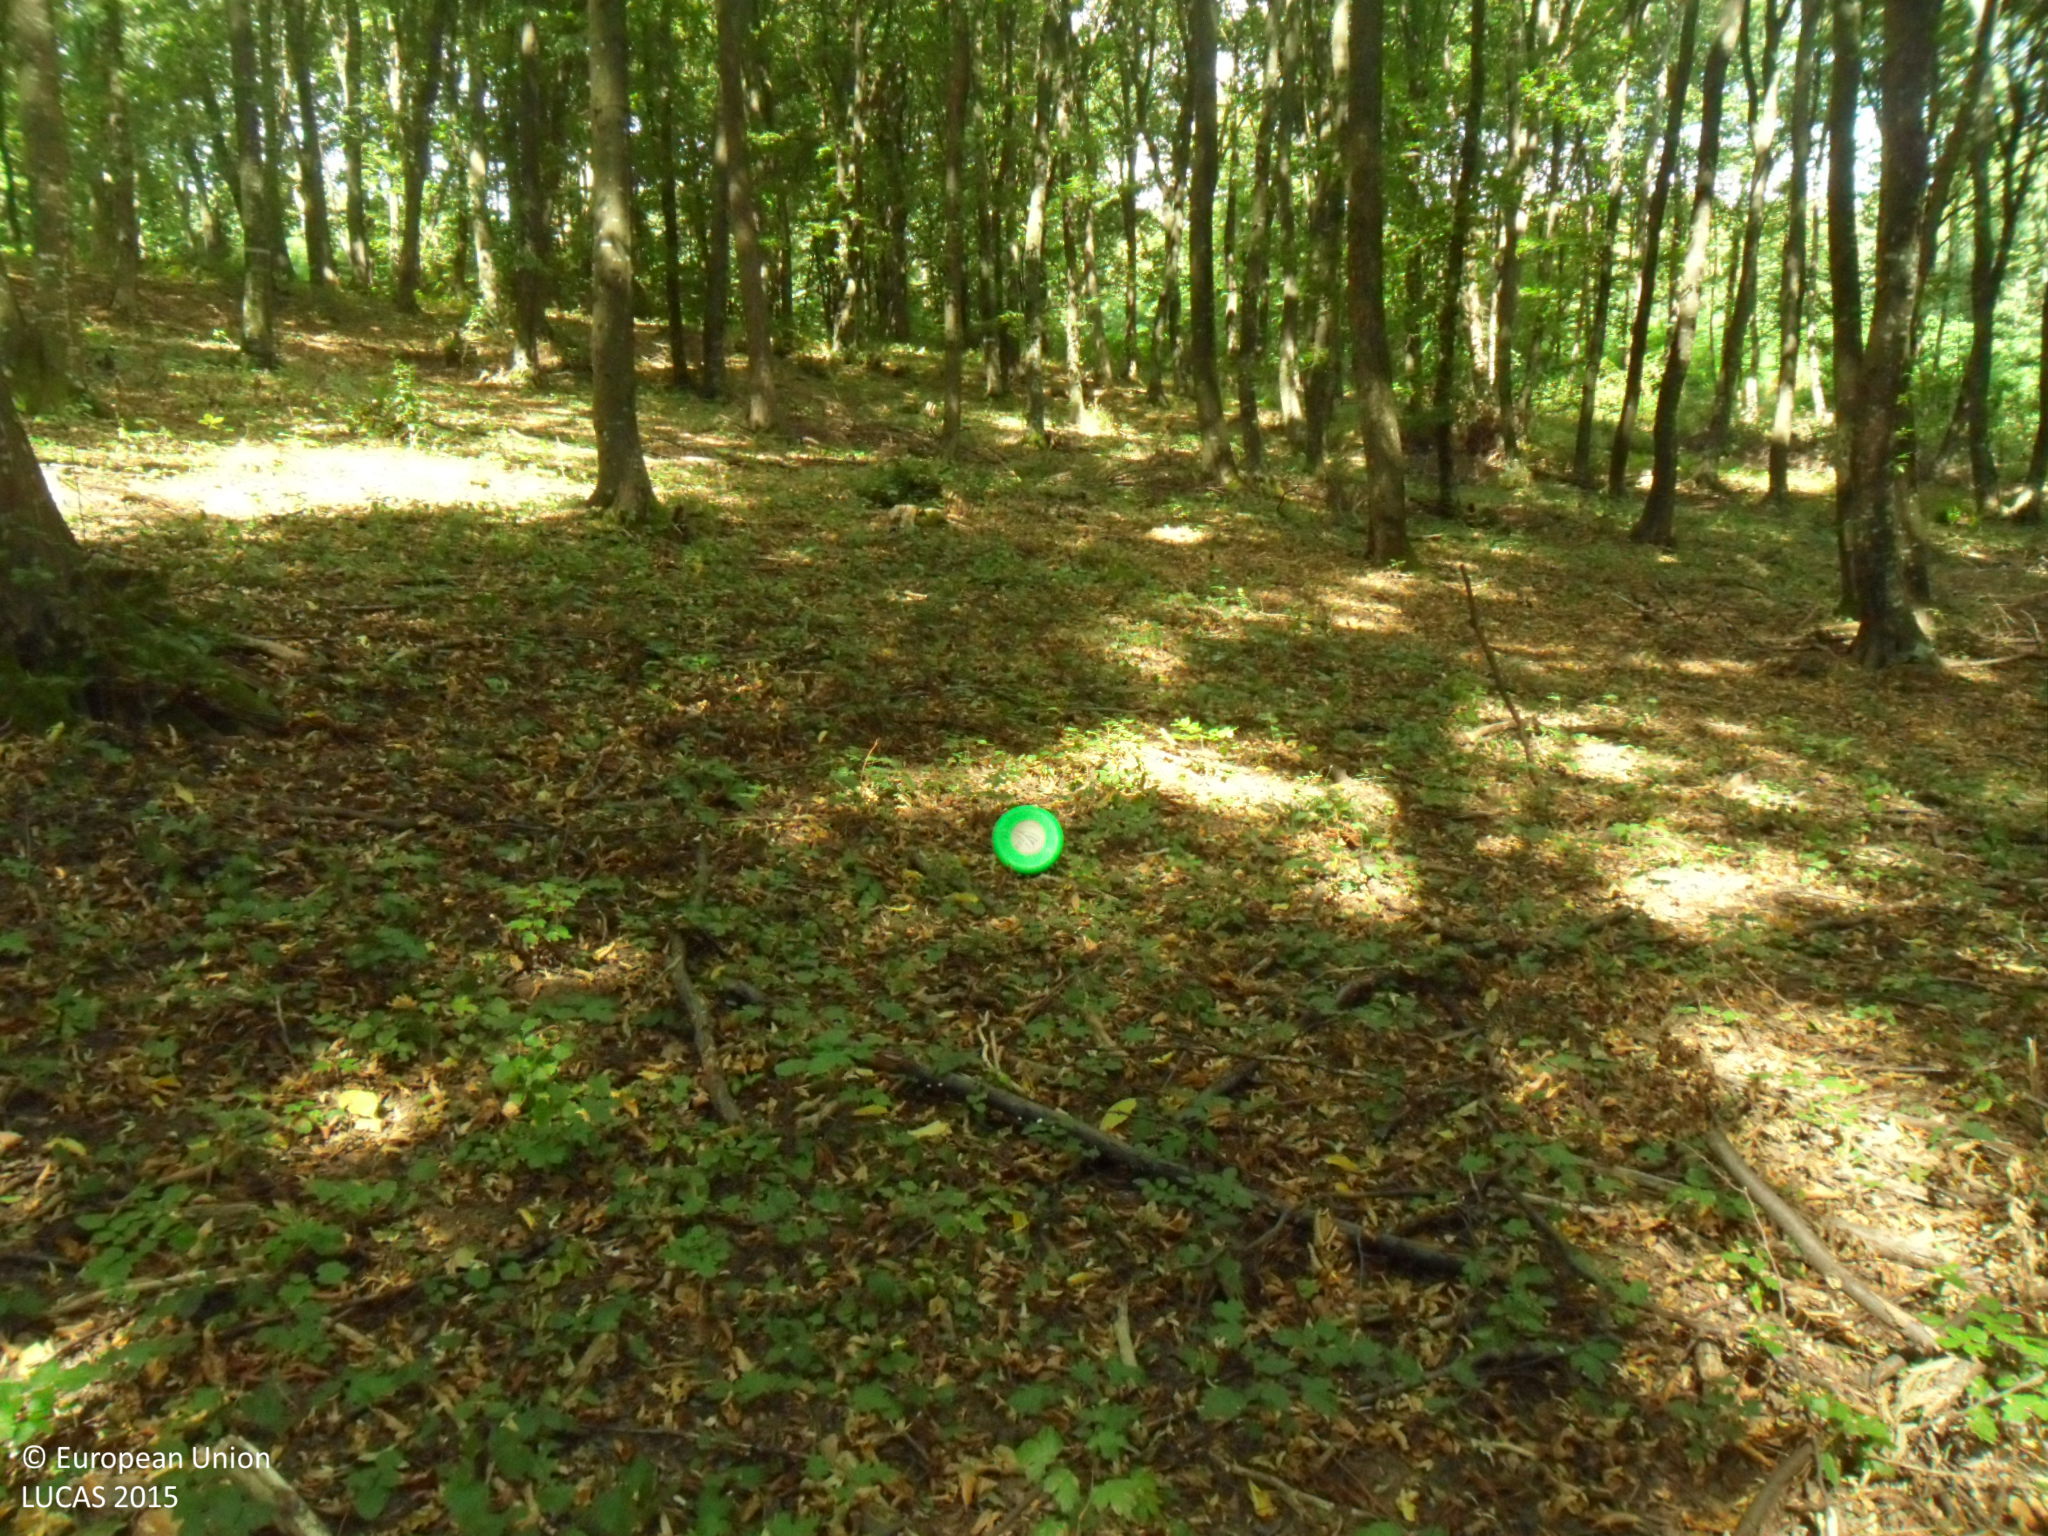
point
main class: Woodland
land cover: Broadleaved woodland
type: beech forest
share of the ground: > 75 %
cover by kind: broadleaved forest trees 100 %
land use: Forestry
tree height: > 5 m
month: September
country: BG
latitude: 43.5684
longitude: 26.2827
